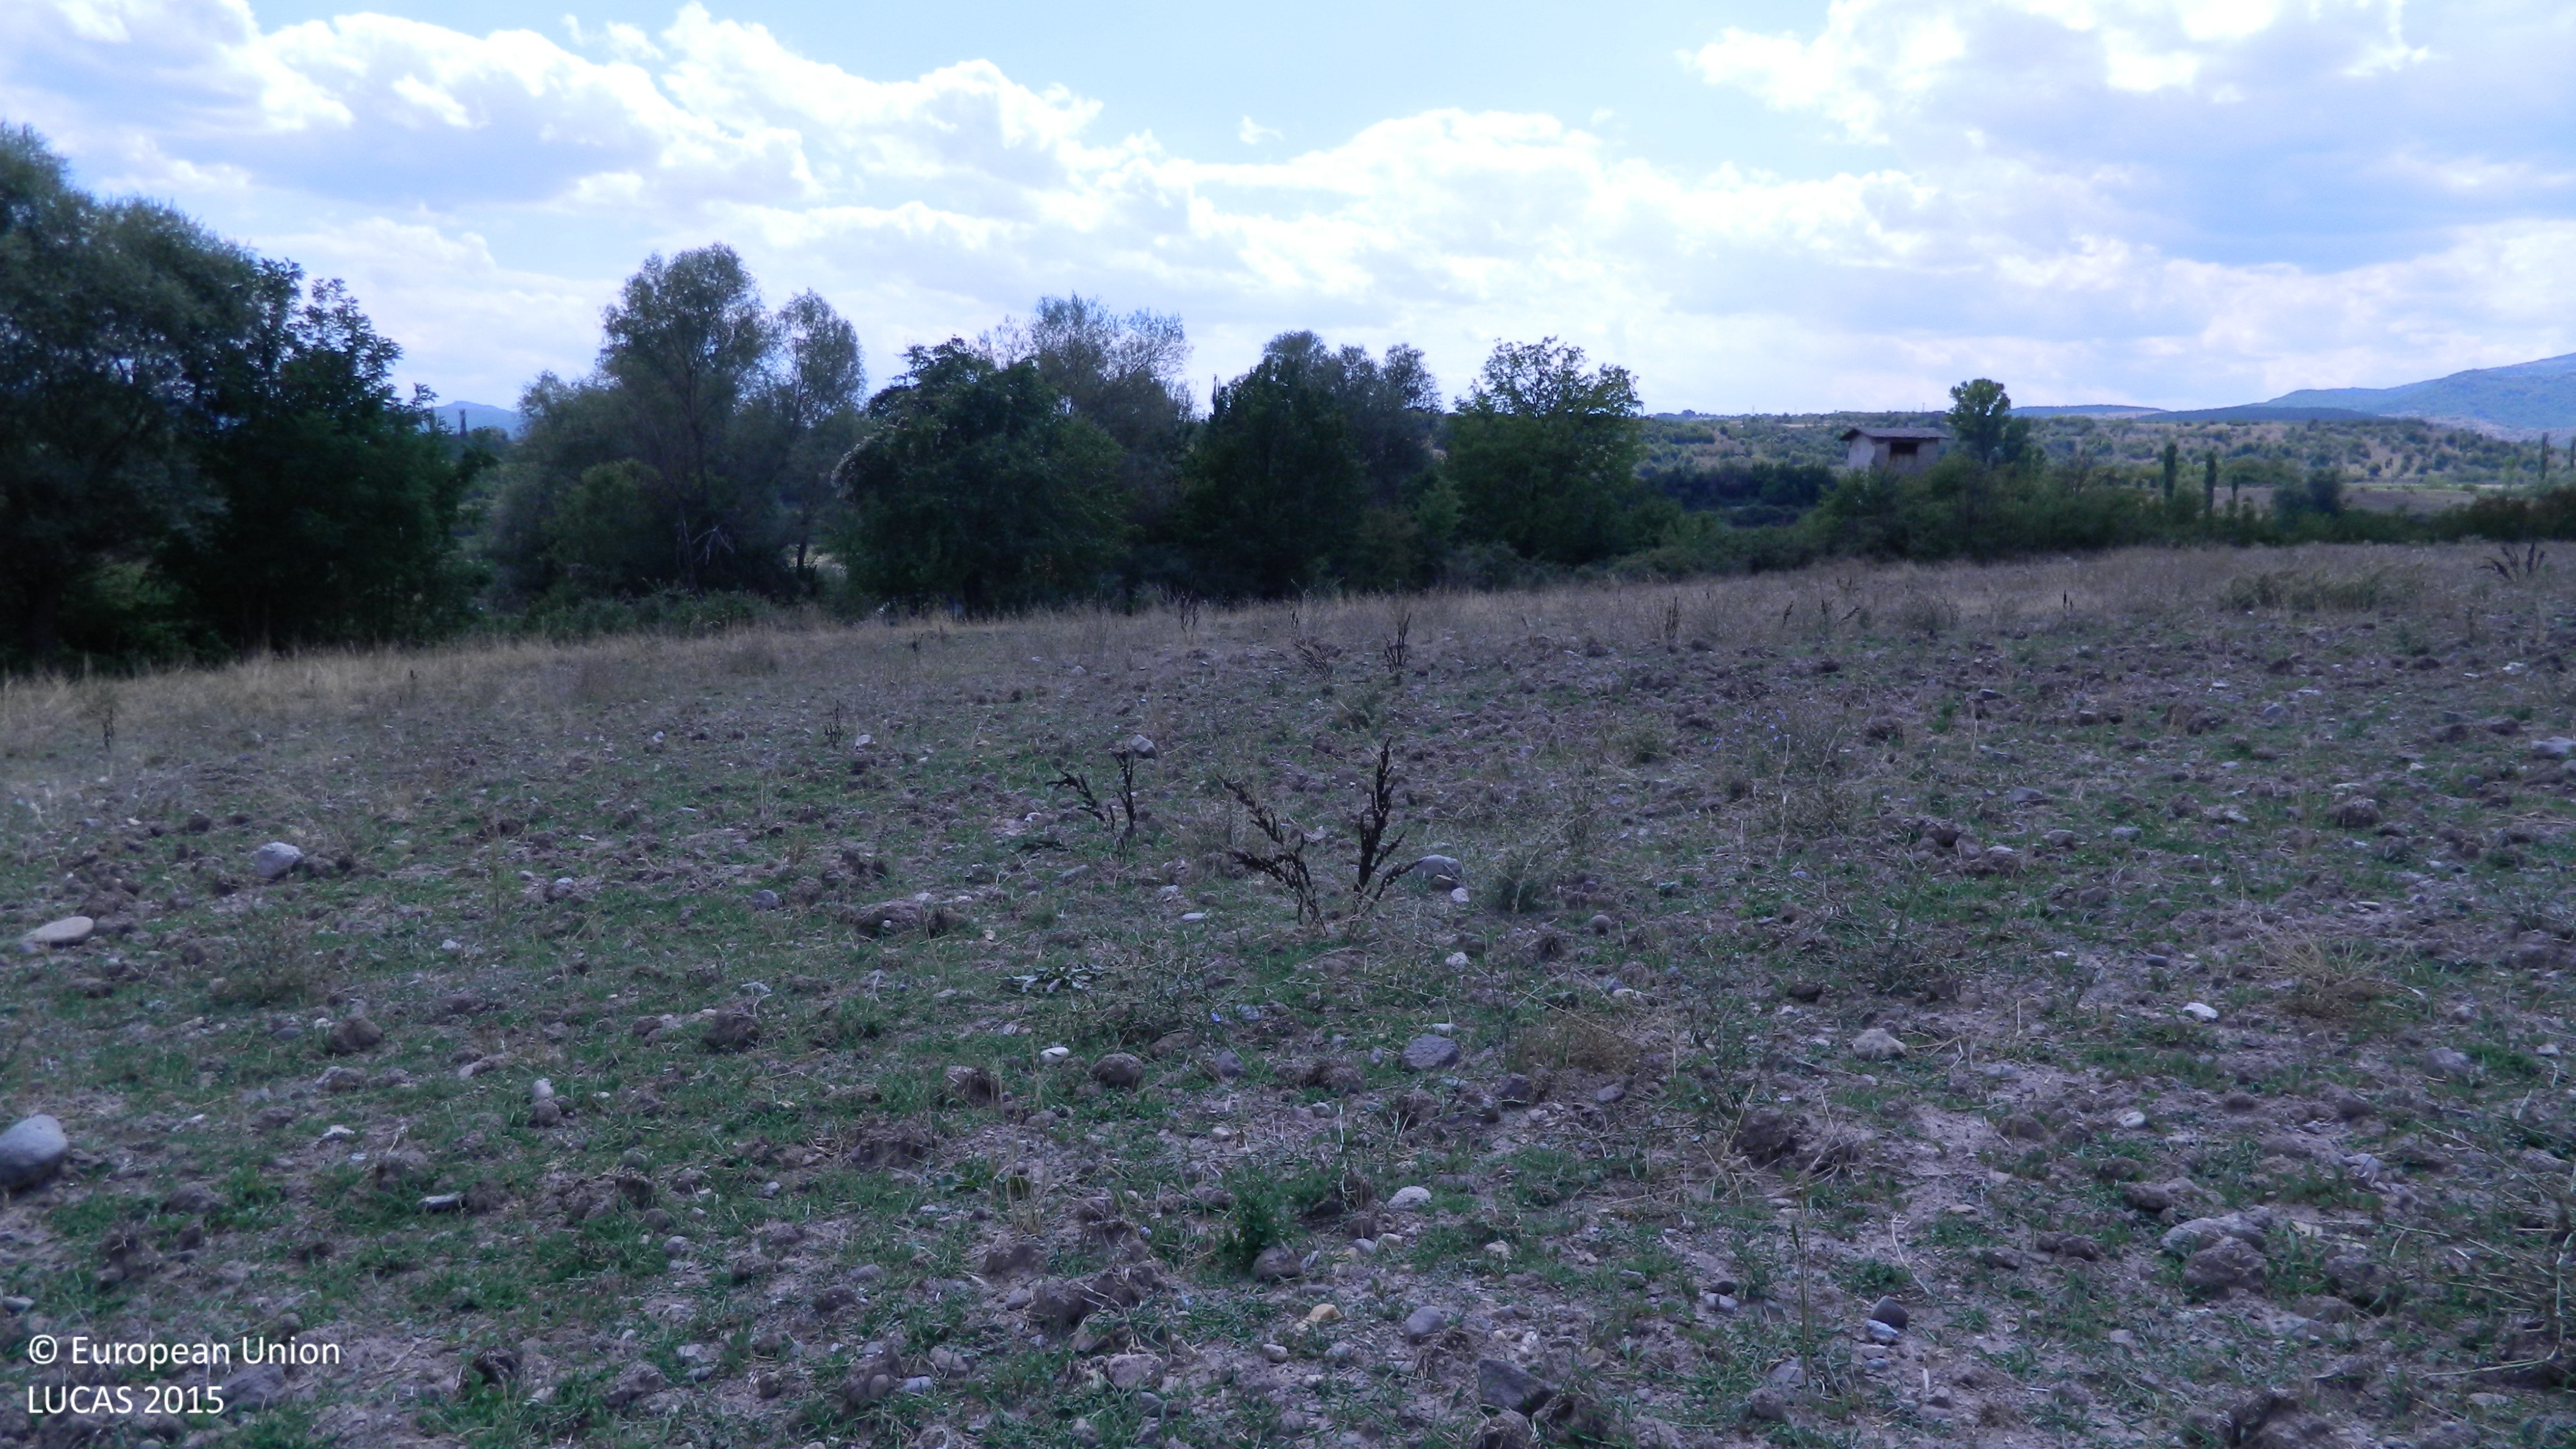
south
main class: Cropland
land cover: Other cereals
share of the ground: < 10 %
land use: Agriculture (excluding fallow land and kitchen gardens)
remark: Harvested field
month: August
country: BG
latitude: 41.6262
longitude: 25.6784
